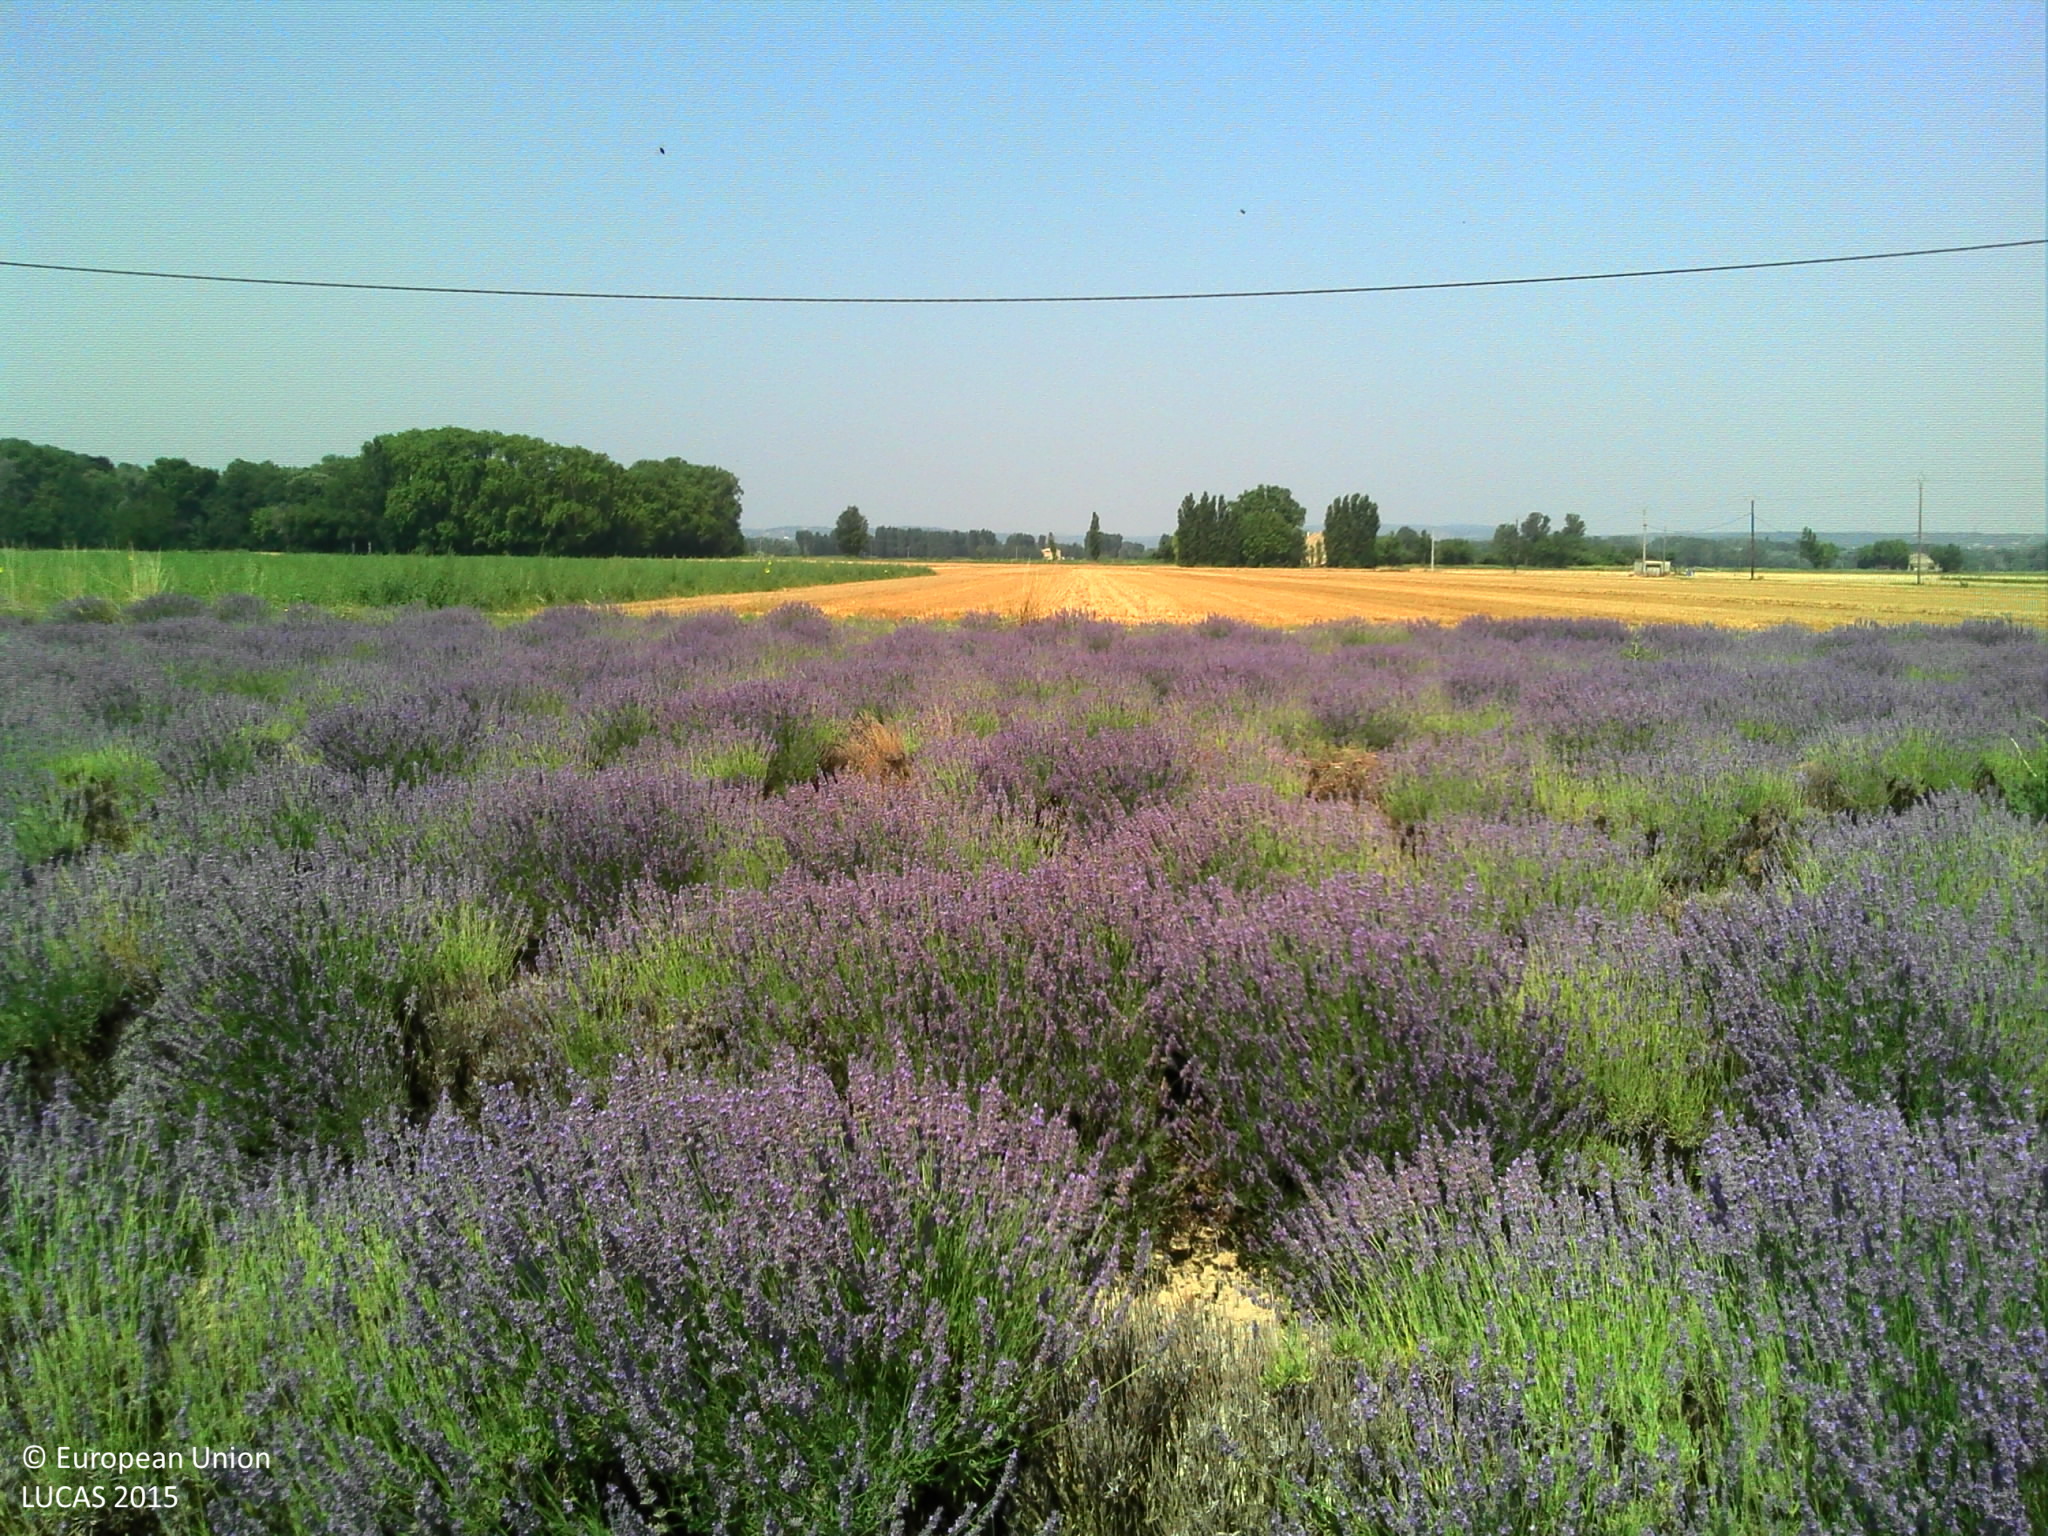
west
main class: Cropland
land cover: Permanent industrial crops
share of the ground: > 75 %
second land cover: Other bare soil
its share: > 75 %
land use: Agriculture (excluding fallow land and kitchen gardens)
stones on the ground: < 10 %
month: July
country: FR
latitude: 44.2865
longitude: 4.6817
